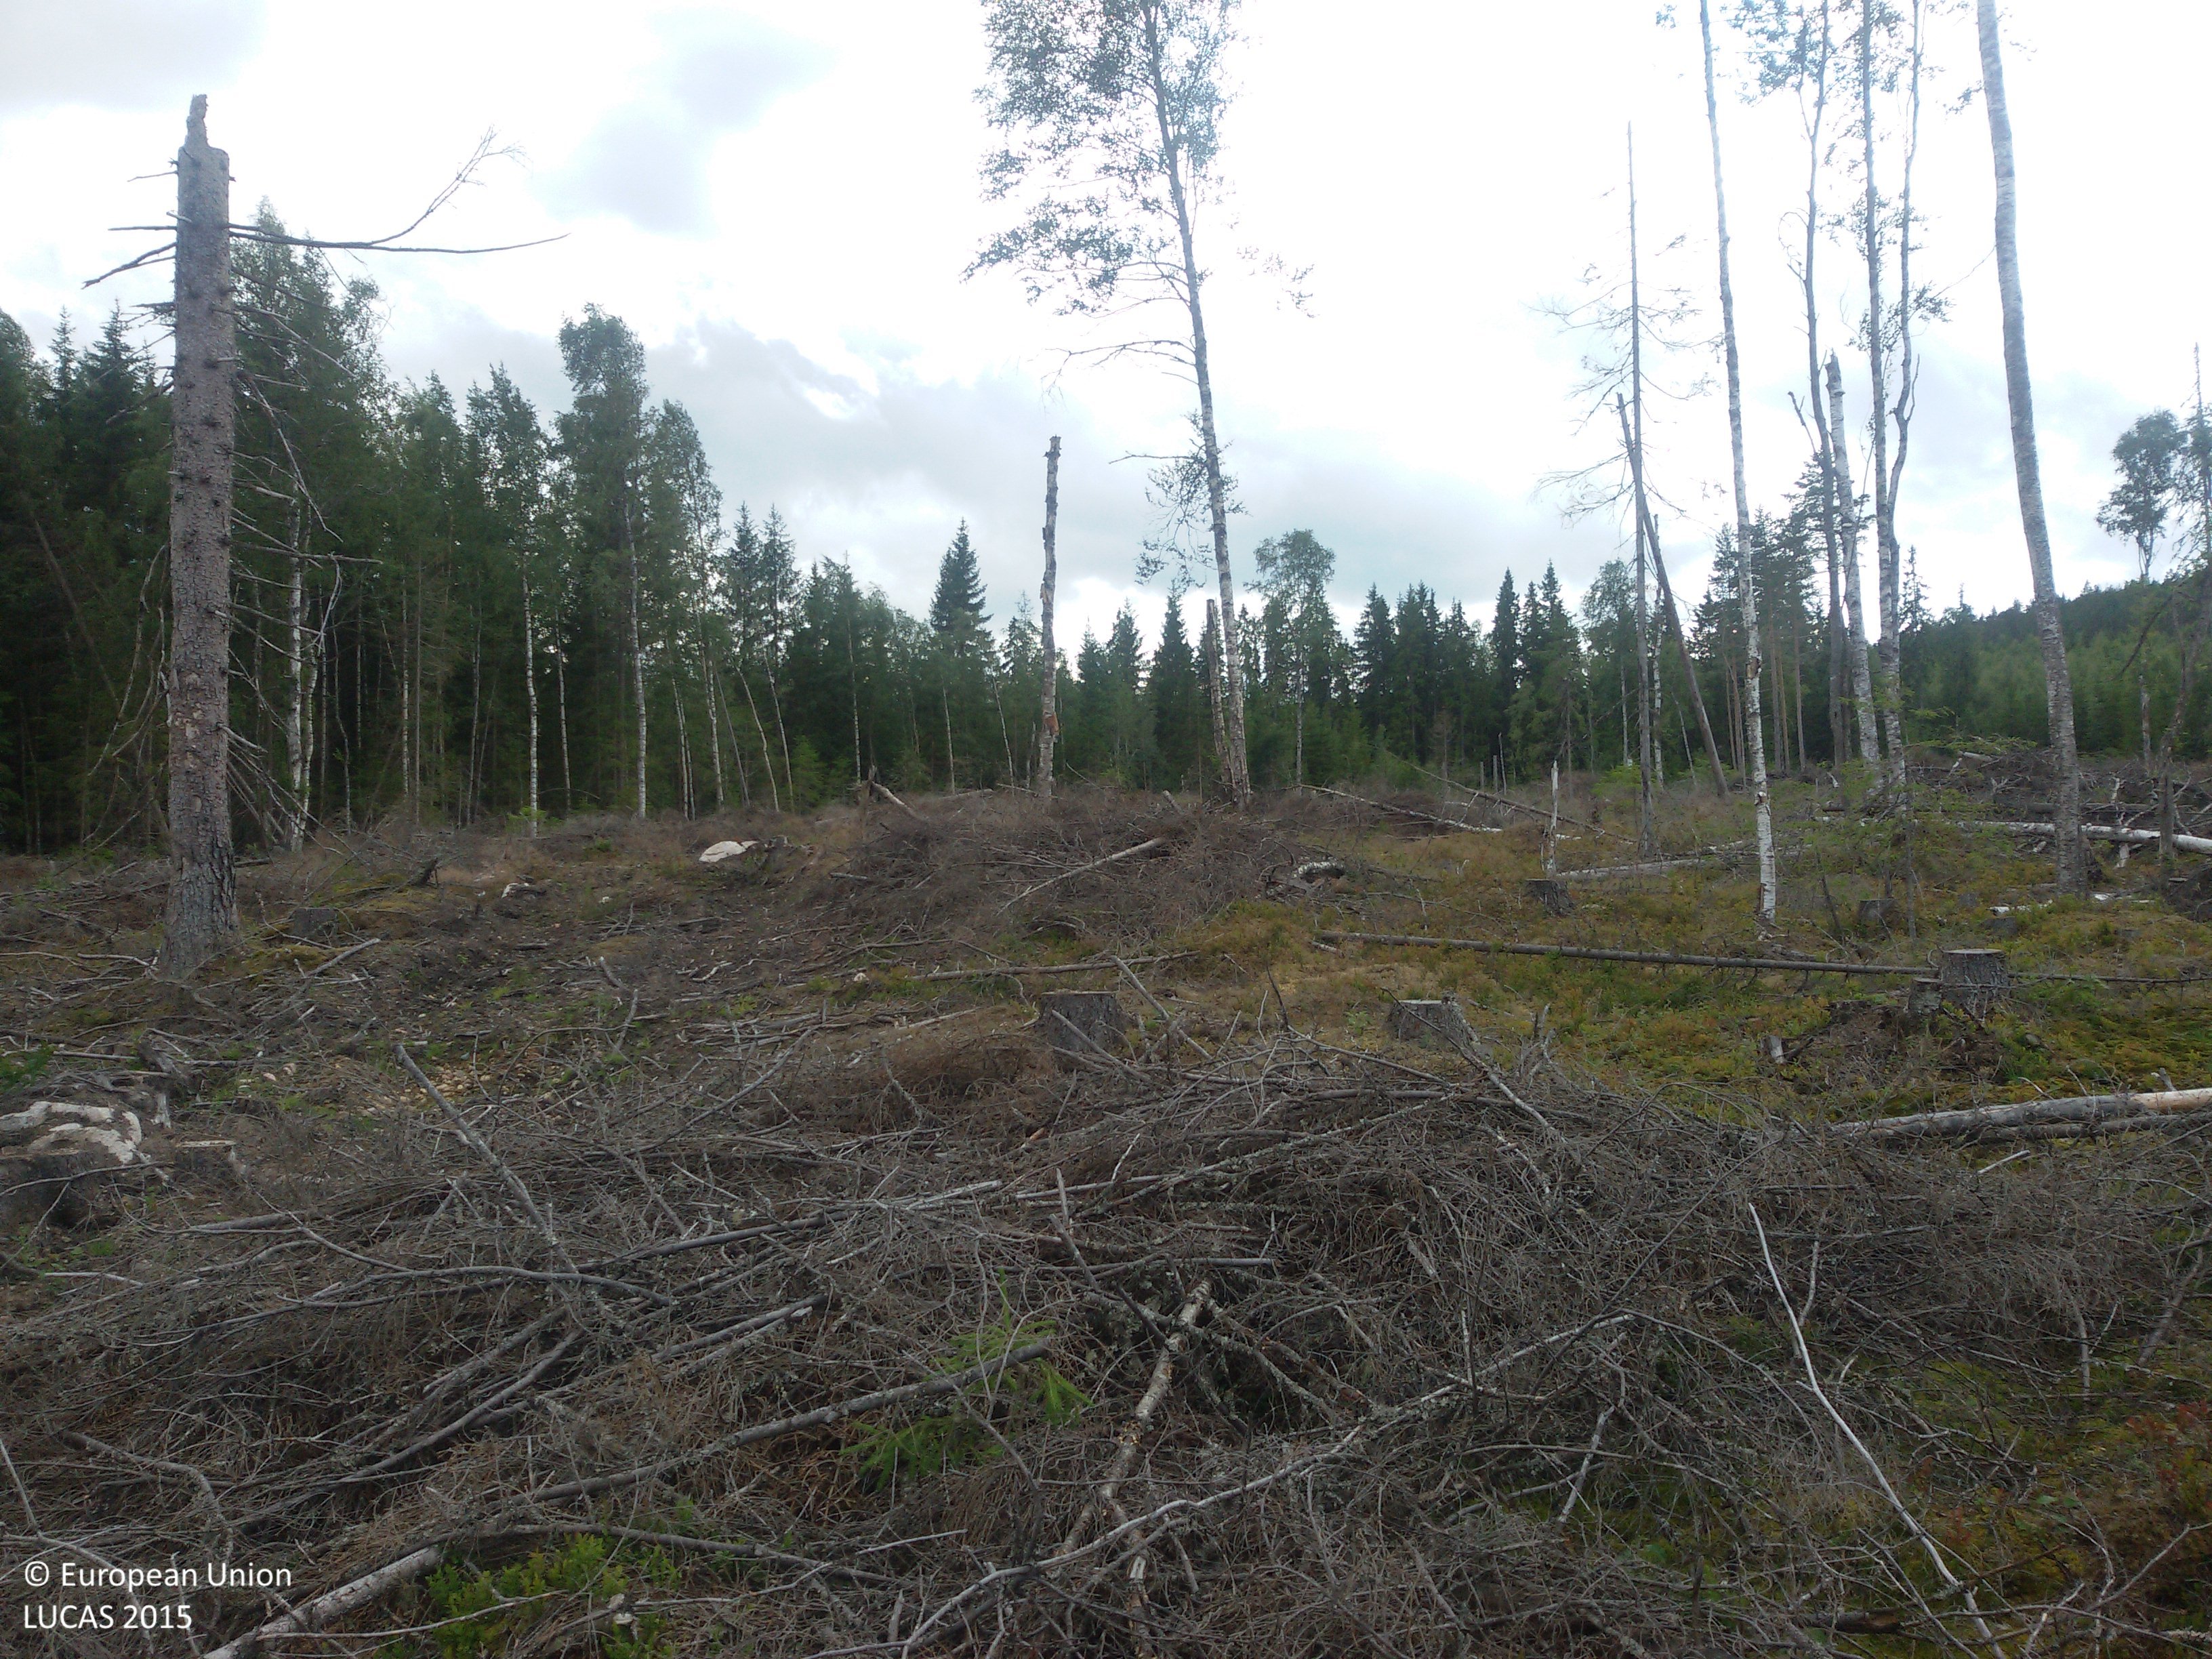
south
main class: Shrubland
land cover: Shrubland without tree cover
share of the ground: 25 - 50 %
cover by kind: shrubs 50 %, unconsolidated bare surface 20 %, lichens and mosses 10 %
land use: Forestry
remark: Clear cut
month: July
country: SE
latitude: 60.5213
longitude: 15.1068
